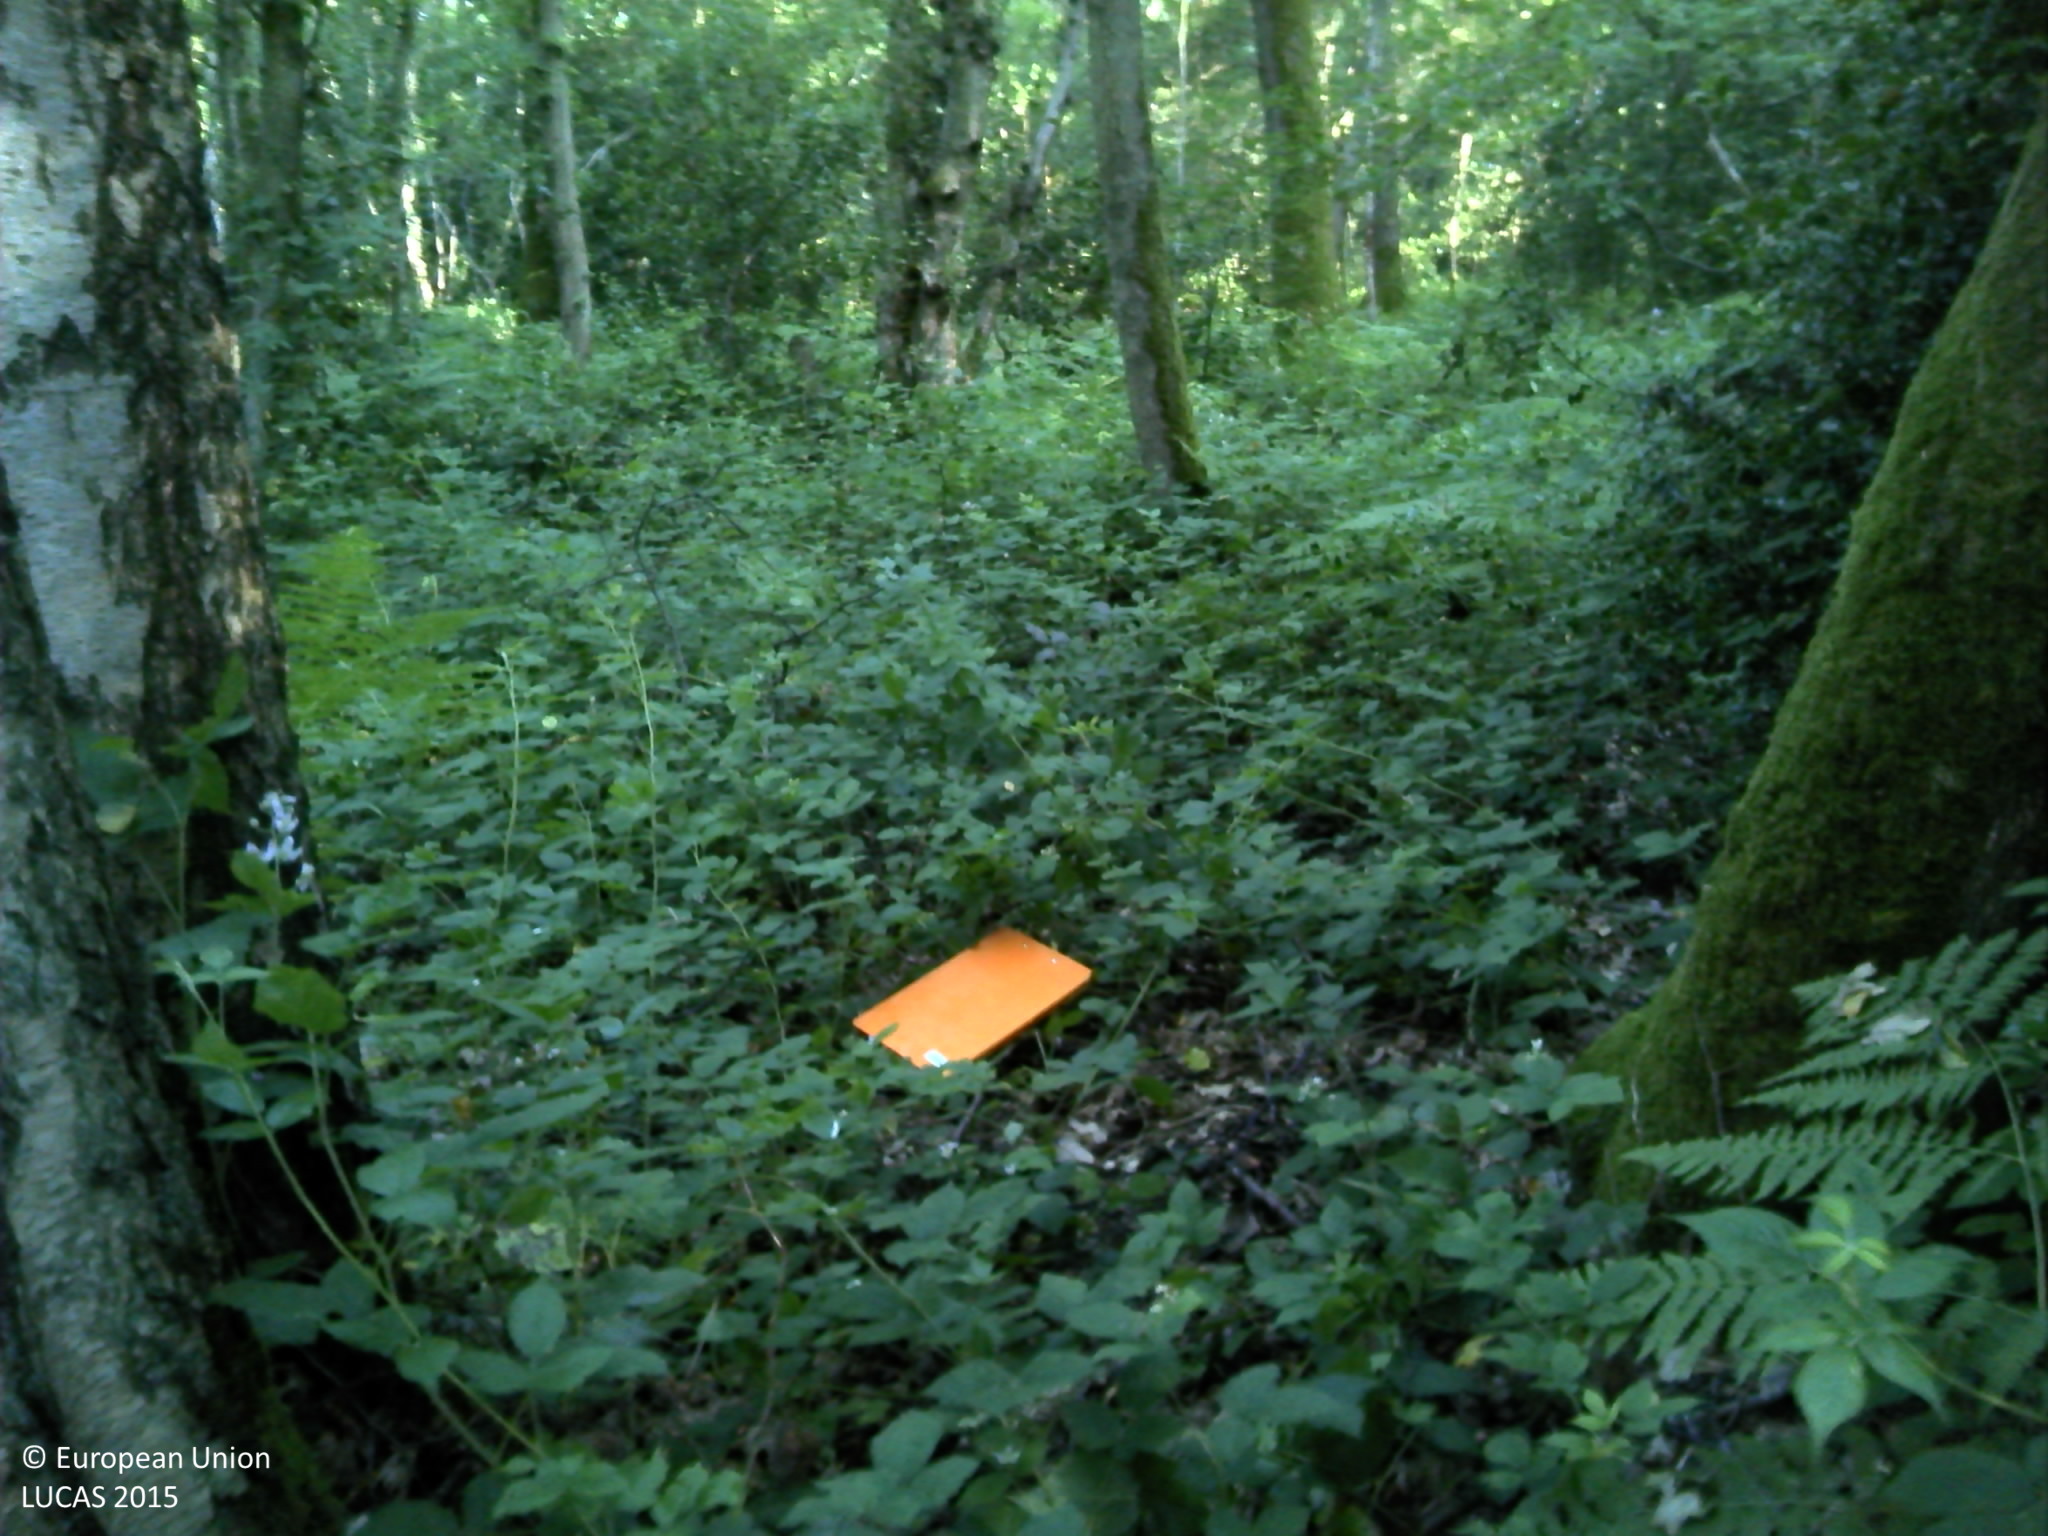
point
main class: Woodland
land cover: Broadleaved woodland
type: acidophilous oak and oak-birch forest
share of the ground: > 75 %
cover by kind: broadleaved forest trees 100 %
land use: Forestry
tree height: > 5 m
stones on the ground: 25 - 50 %
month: July
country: FR
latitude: 49.3579
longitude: 1.2370
